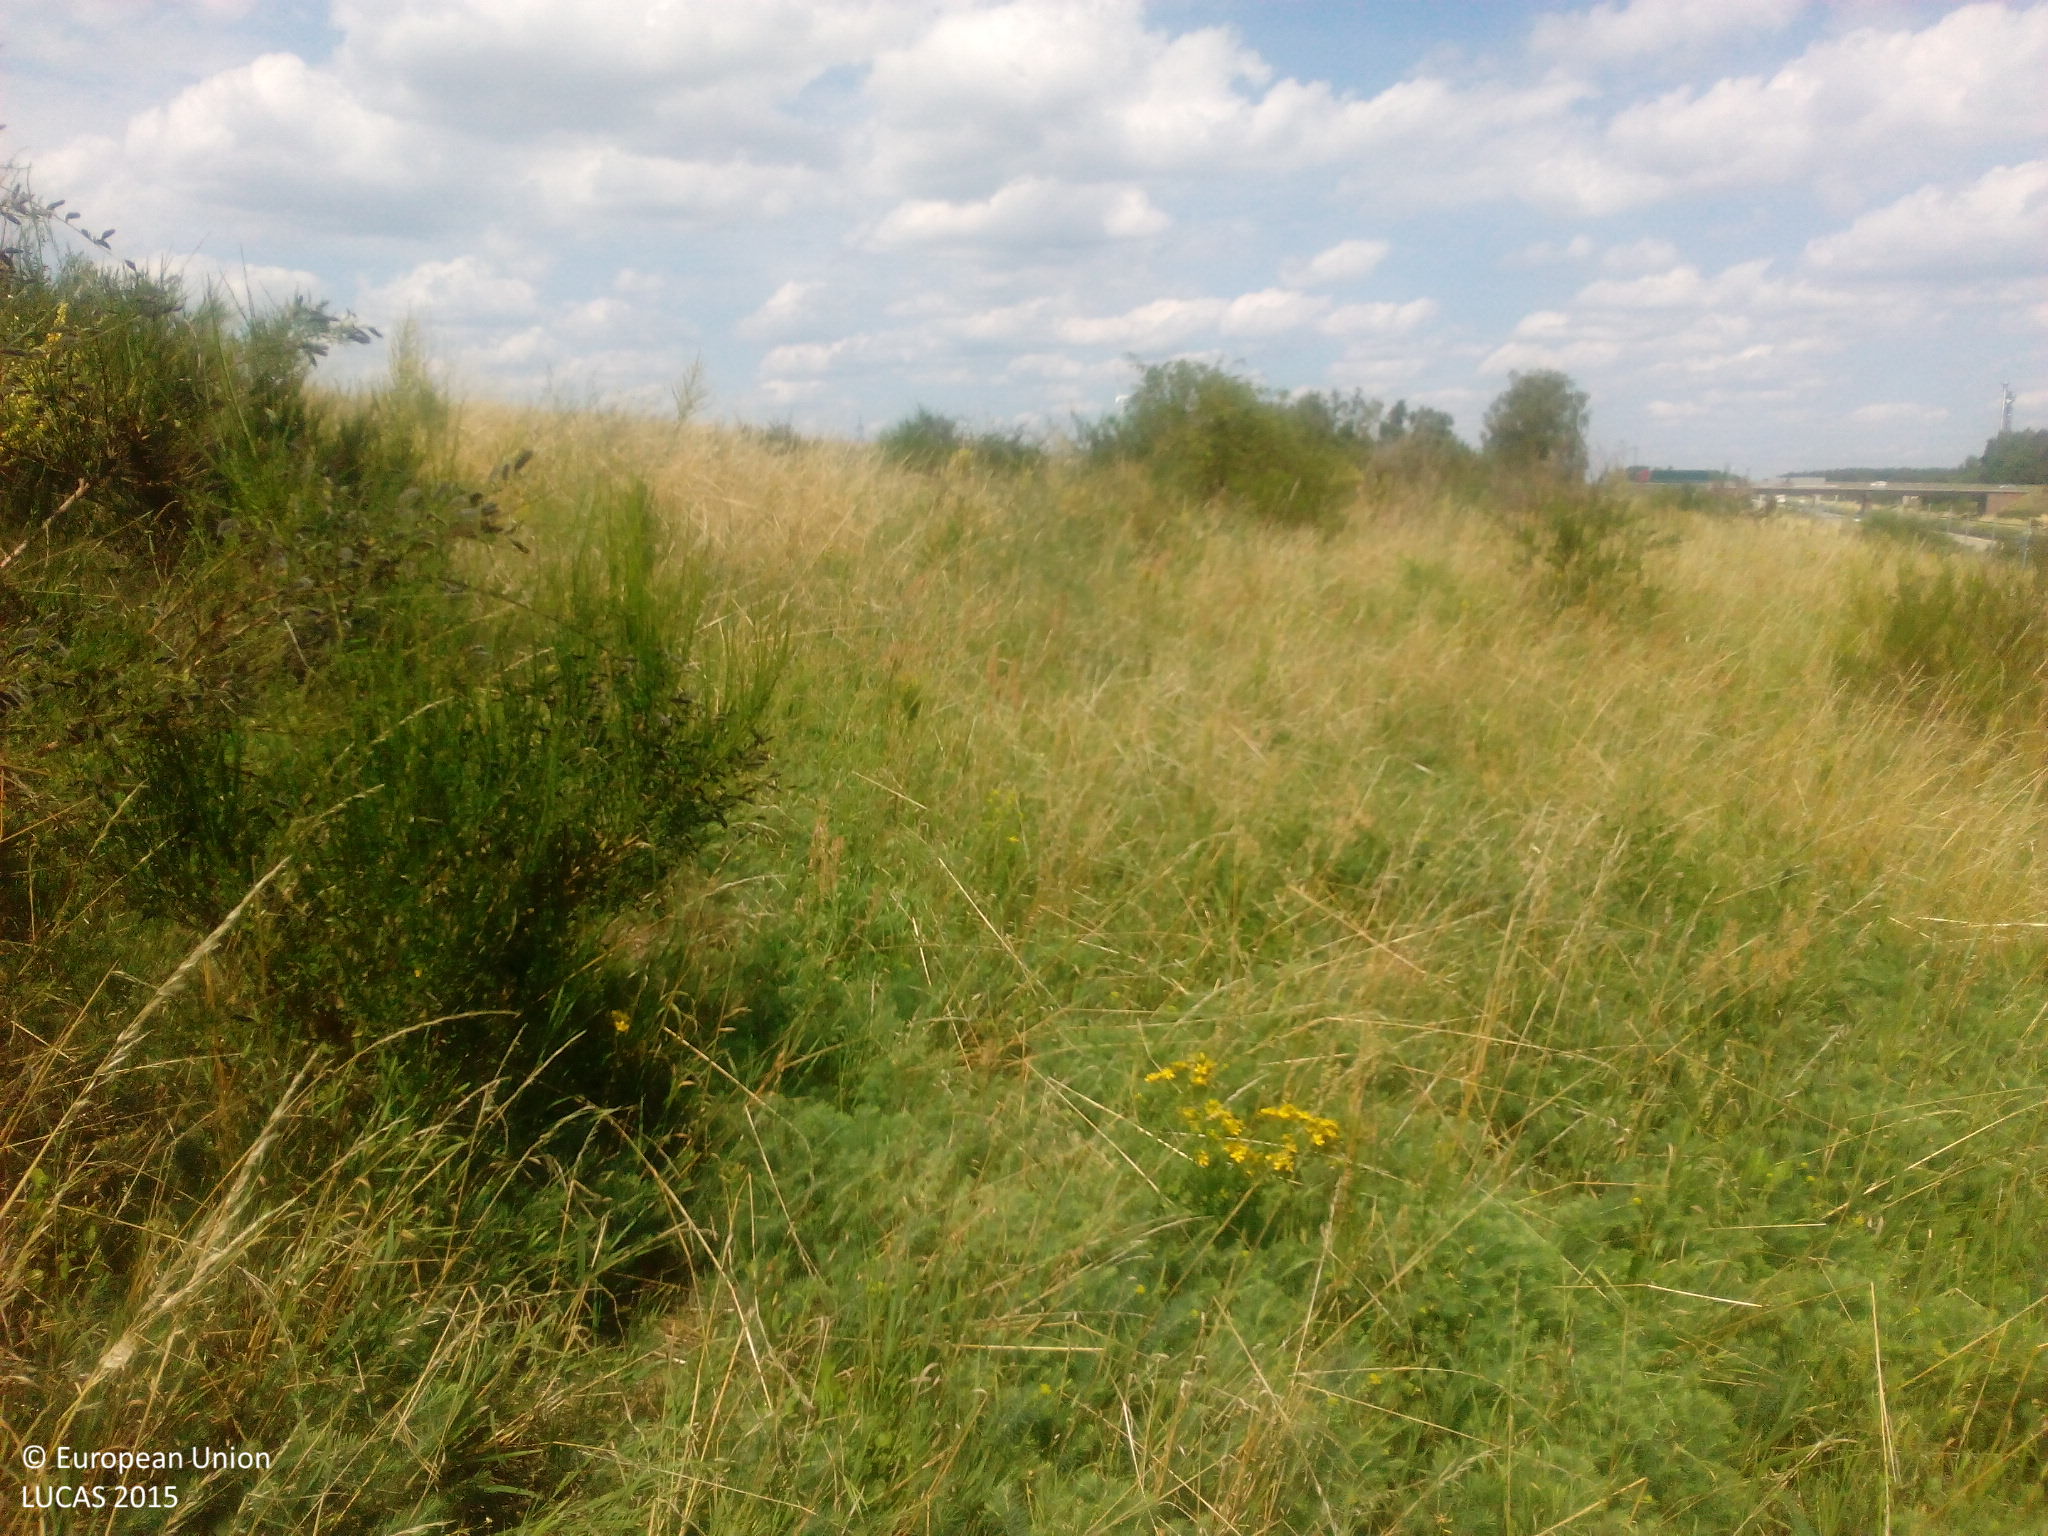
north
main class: Grassland
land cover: Grassland without tree/shrub cover
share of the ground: > 75 %
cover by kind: herbaceous plants 100 %
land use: Road transport
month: July
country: DE
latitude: 51.8858
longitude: 12.3969
